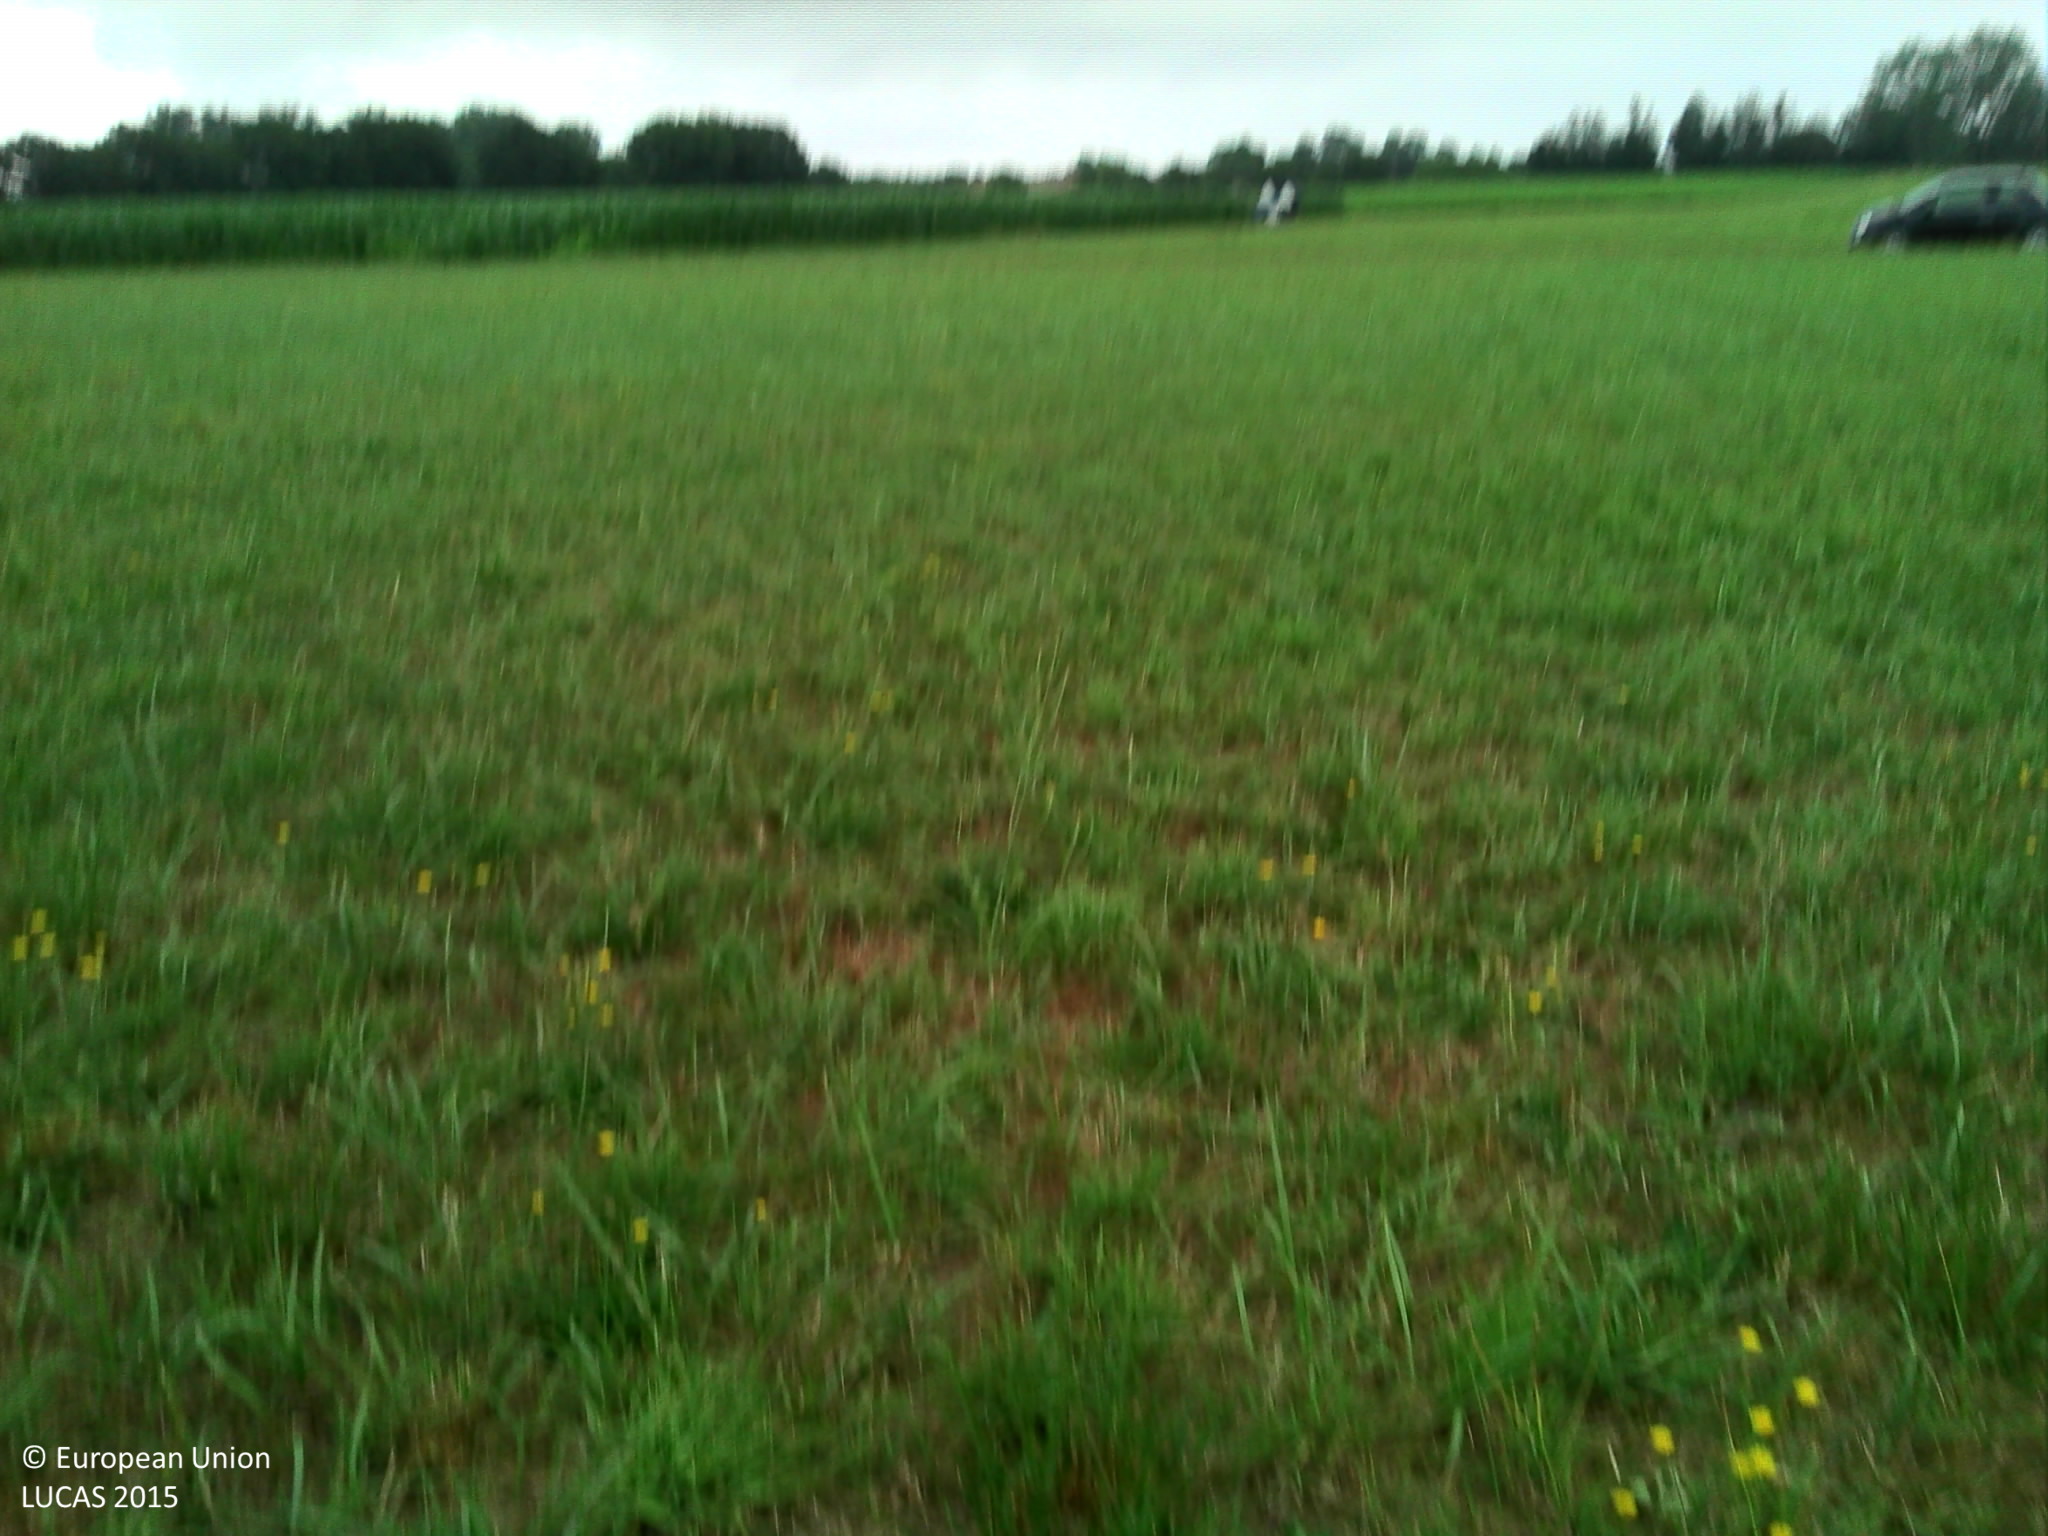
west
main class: Grassland
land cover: Grassland without tree/shrub cover
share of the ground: > 75 %
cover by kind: herbaceous plants 100 %
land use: Agriculture (excluding fallow land and kitchen gardens)
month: July
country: FR
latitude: 43.6321
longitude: -1.2089
